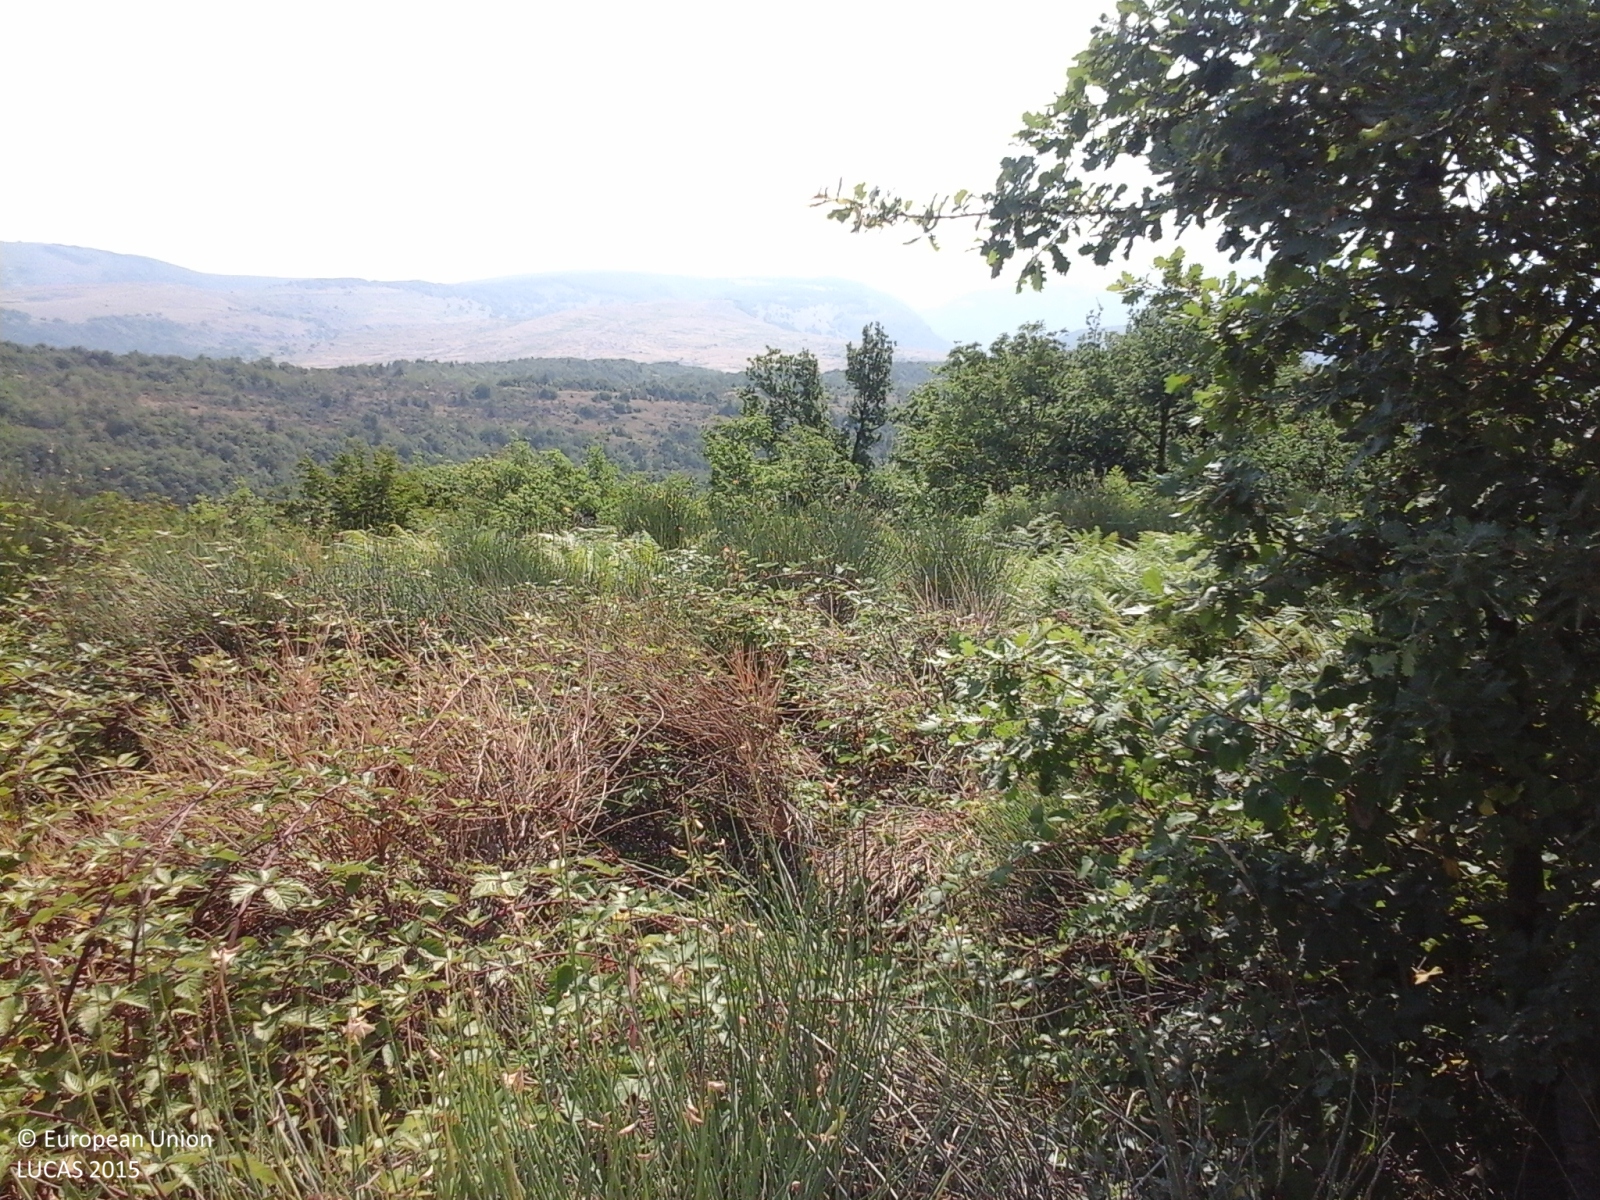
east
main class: Shrubland
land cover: Shrubland without tree cover
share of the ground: > 75 %
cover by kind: shrubs 90 %, herbaceous plants 10 %
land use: Semi-natural and natural areas not in use
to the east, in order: Shrubland without tree cover; Broadleaved woodland; Grassland without tree/shrub cover; Broadleaved woodland
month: July
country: IT
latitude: 42.1945
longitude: 14.0197
